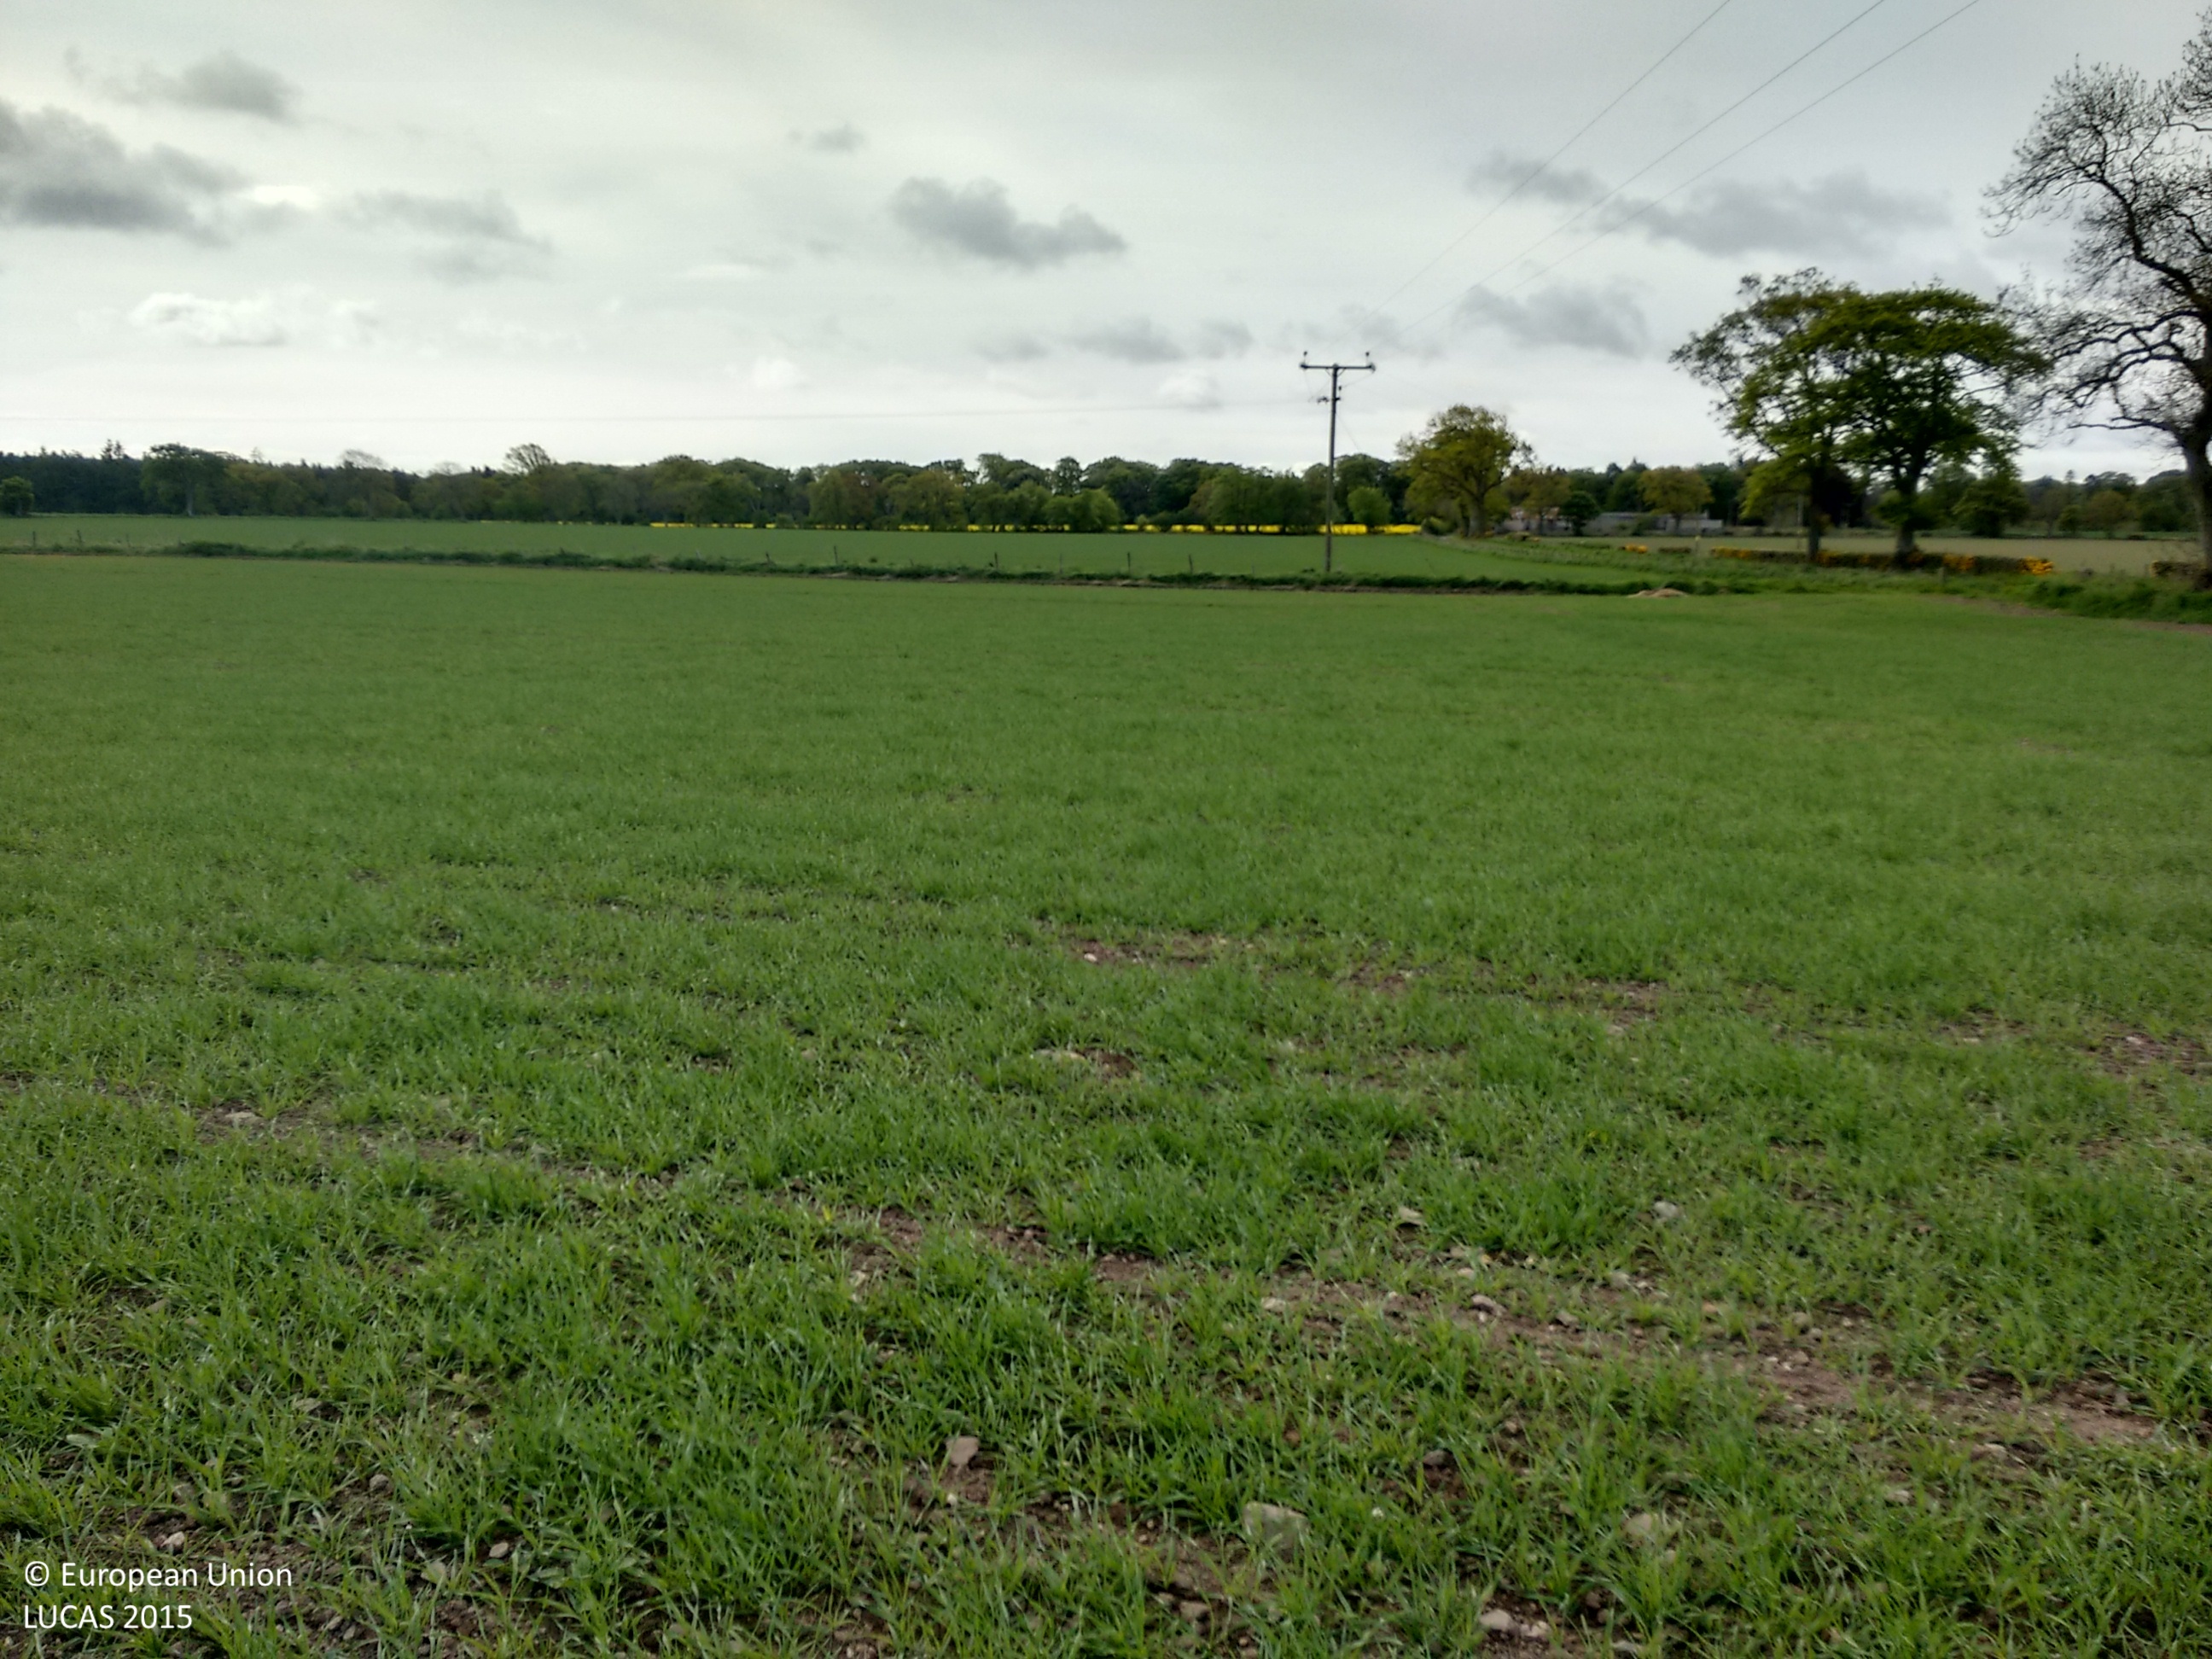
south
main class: Cropland
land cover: Barley
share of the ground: > 75 %
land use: Agriculture (excluding fallow land and kitchen gardens)
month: May
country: GB
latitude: 56.5736
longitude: -2.7075
